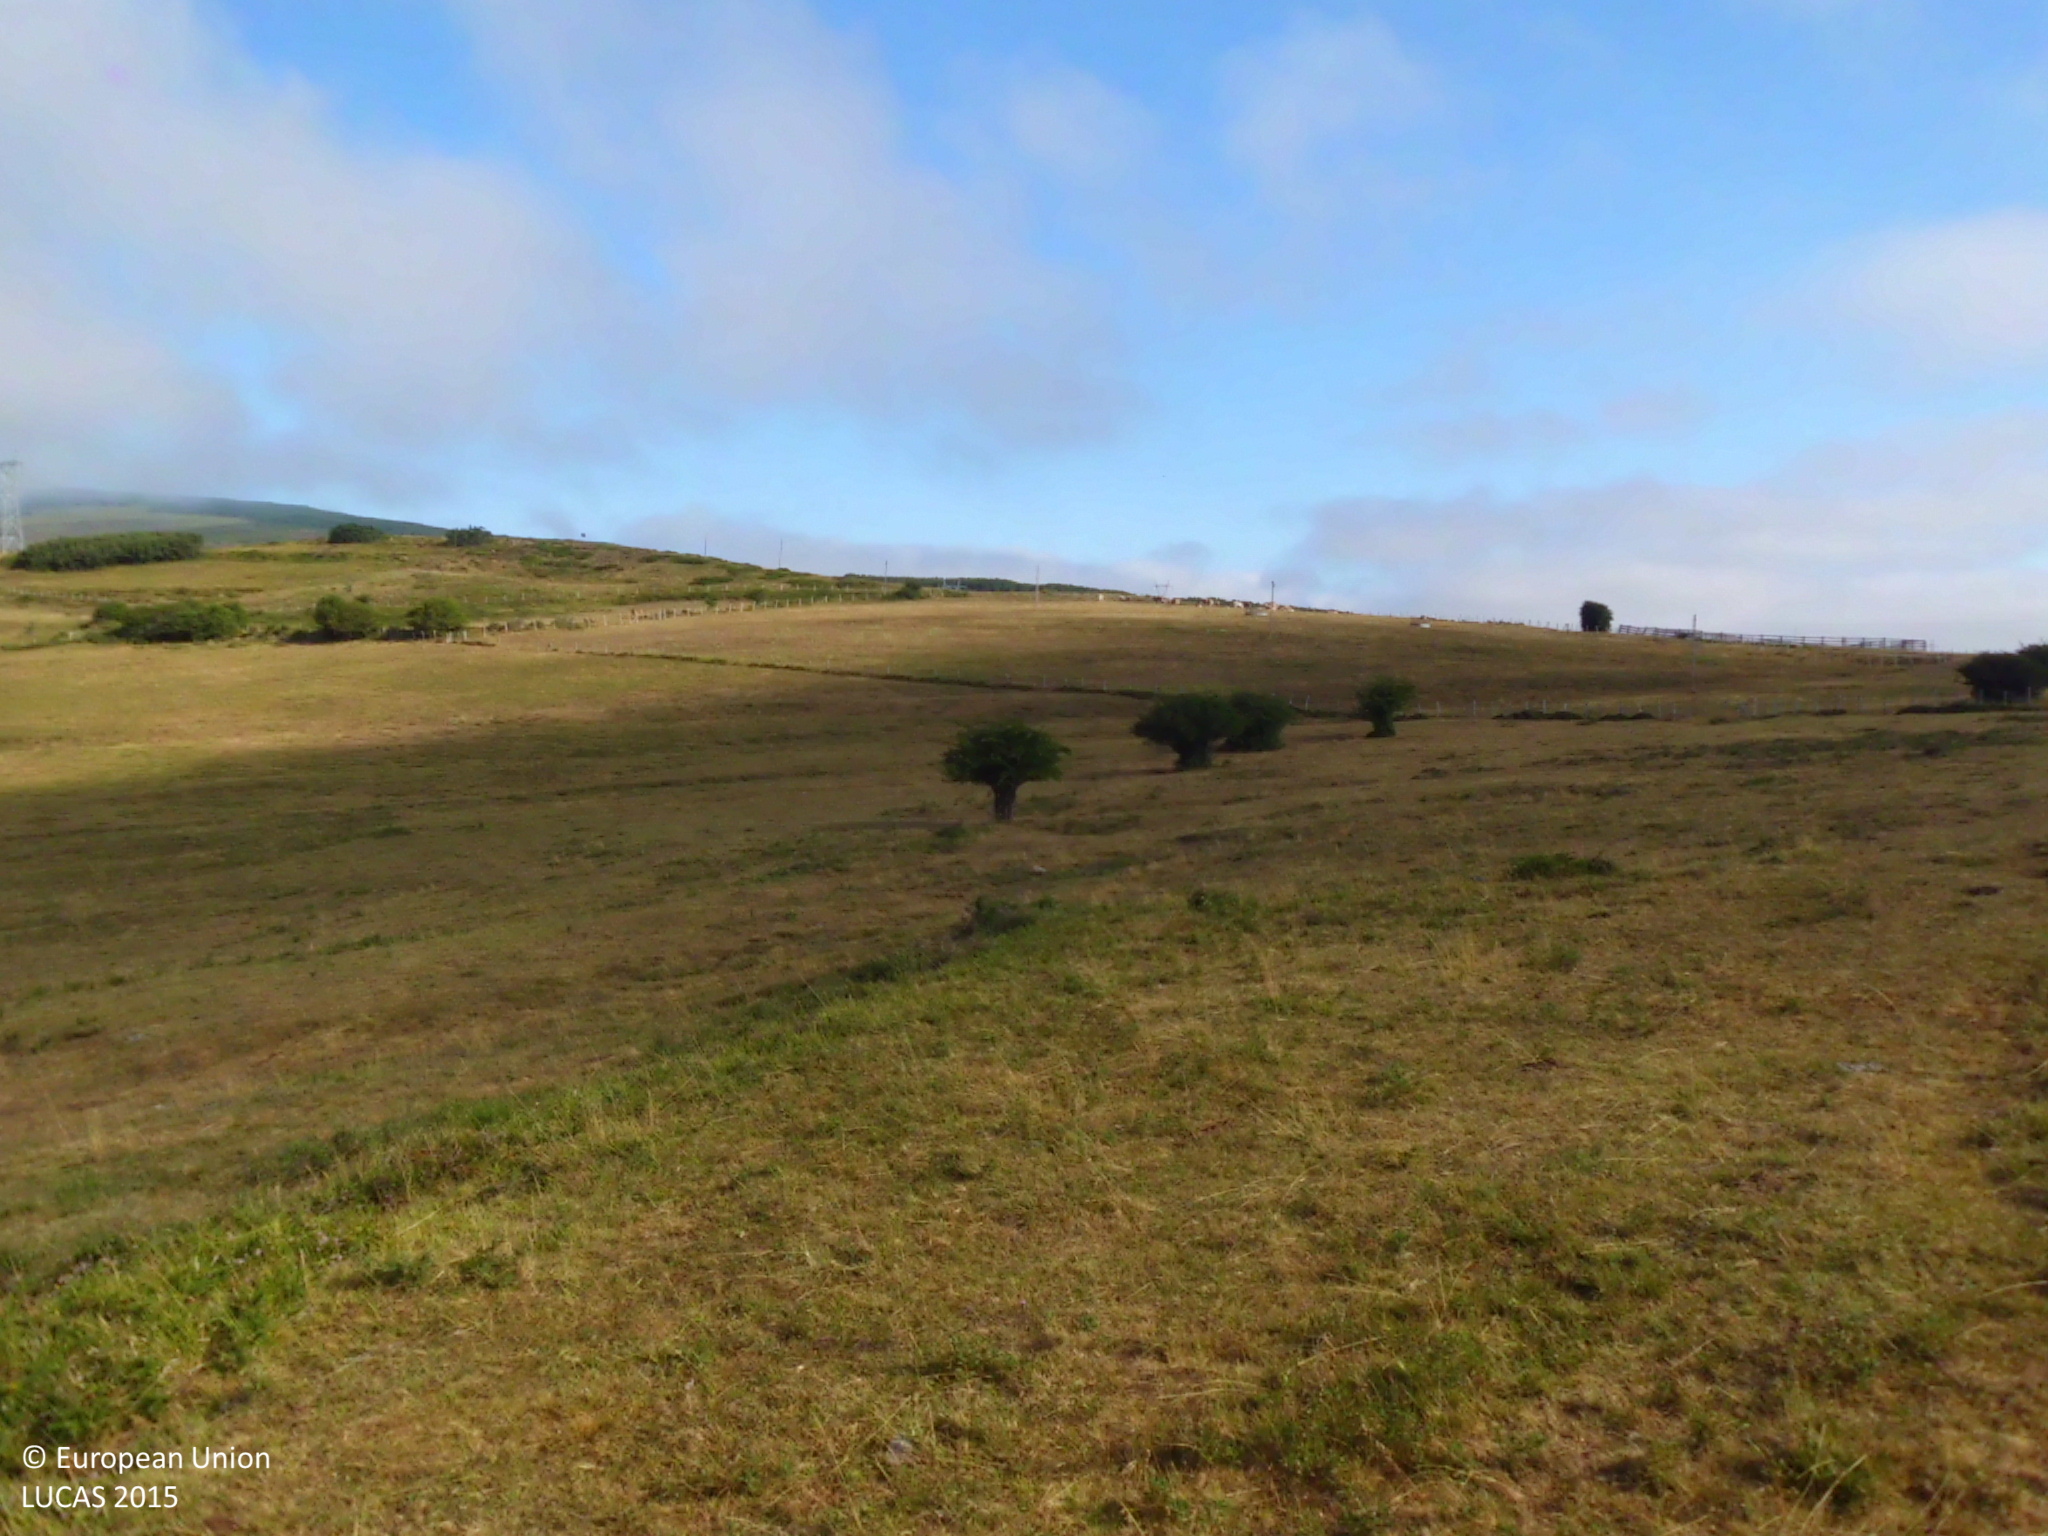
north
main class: Grassland
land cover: Grassland without tree/shrub cover
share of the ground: > 75 %
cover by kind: herbaceous plants 100 %
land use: Agriculture (excluding fallow land and kitchen gardens)
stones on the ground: < 10 %
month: July
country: ES
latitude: 42.9356
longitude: -4.1540
